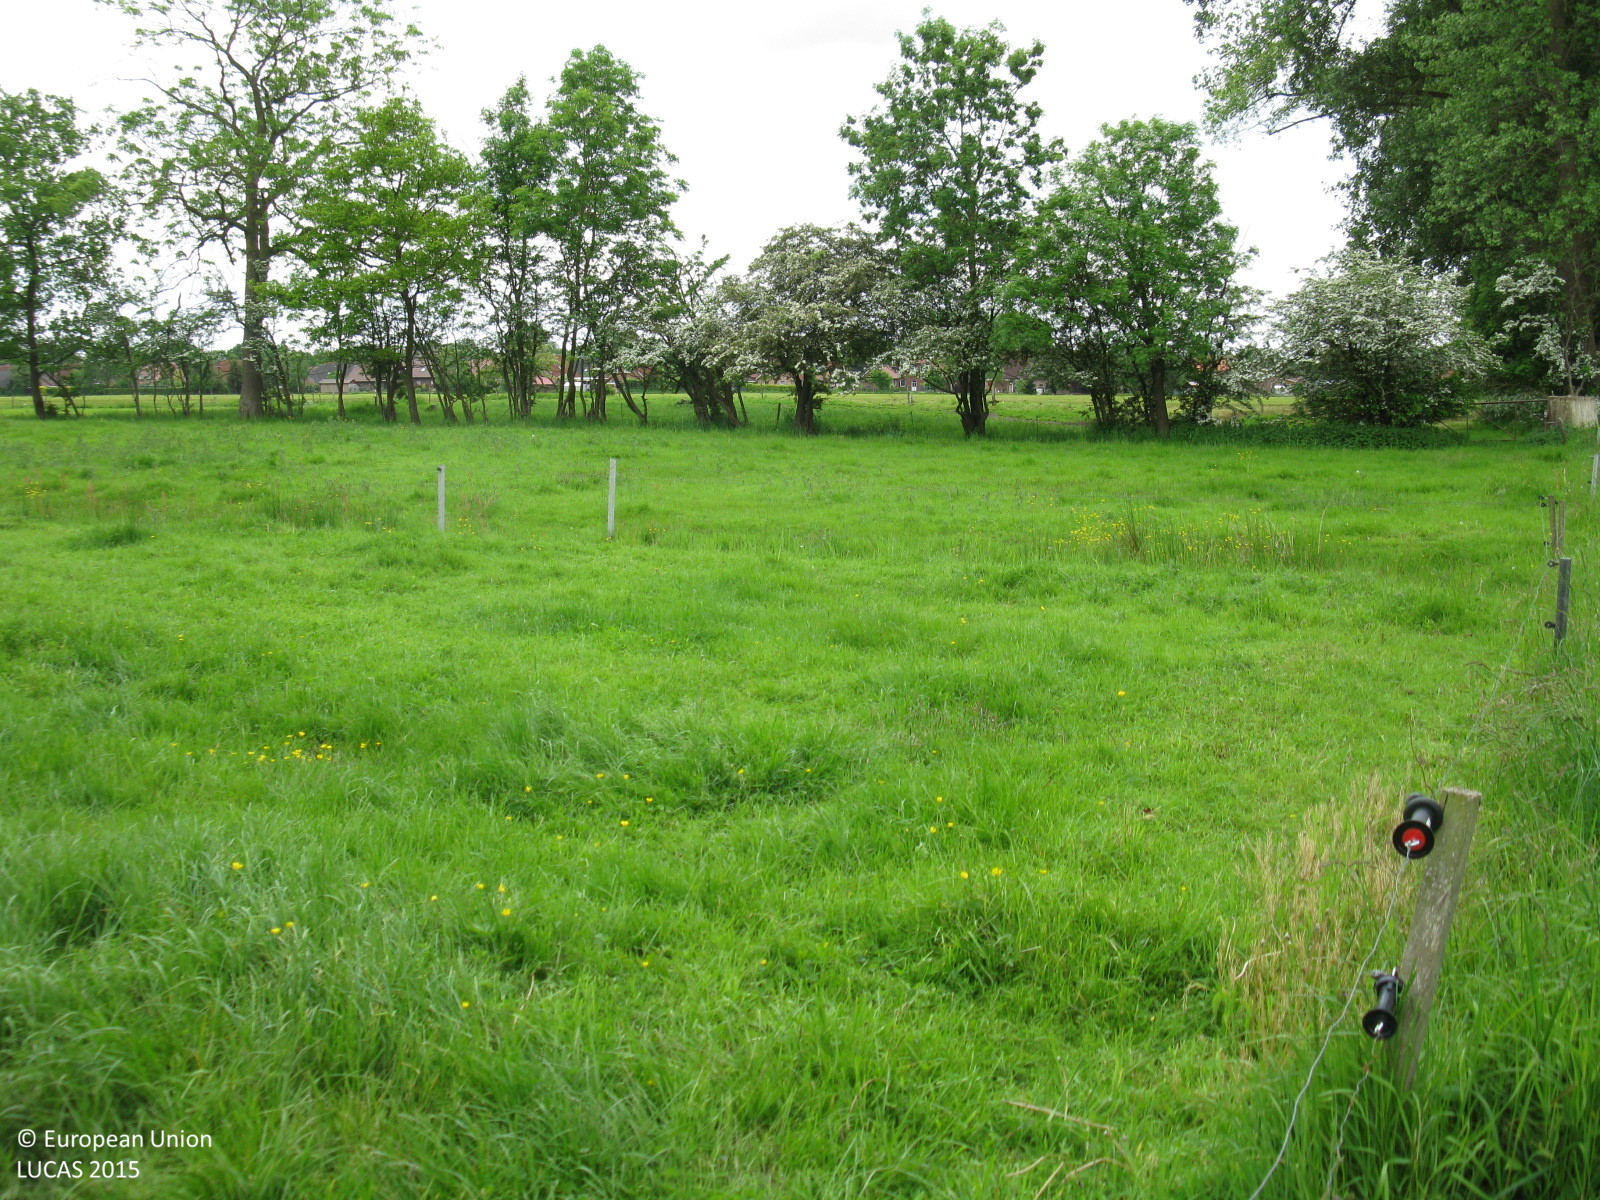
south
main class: Grassland
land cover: Grassland without tree/shrub cover
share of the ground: > 75 %
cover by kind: herbaceous plants 100 %
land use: Agriculture (excluding fallow land and kitchen gardens)
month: June
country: DE
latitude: 53.1566
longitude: 7.3236
